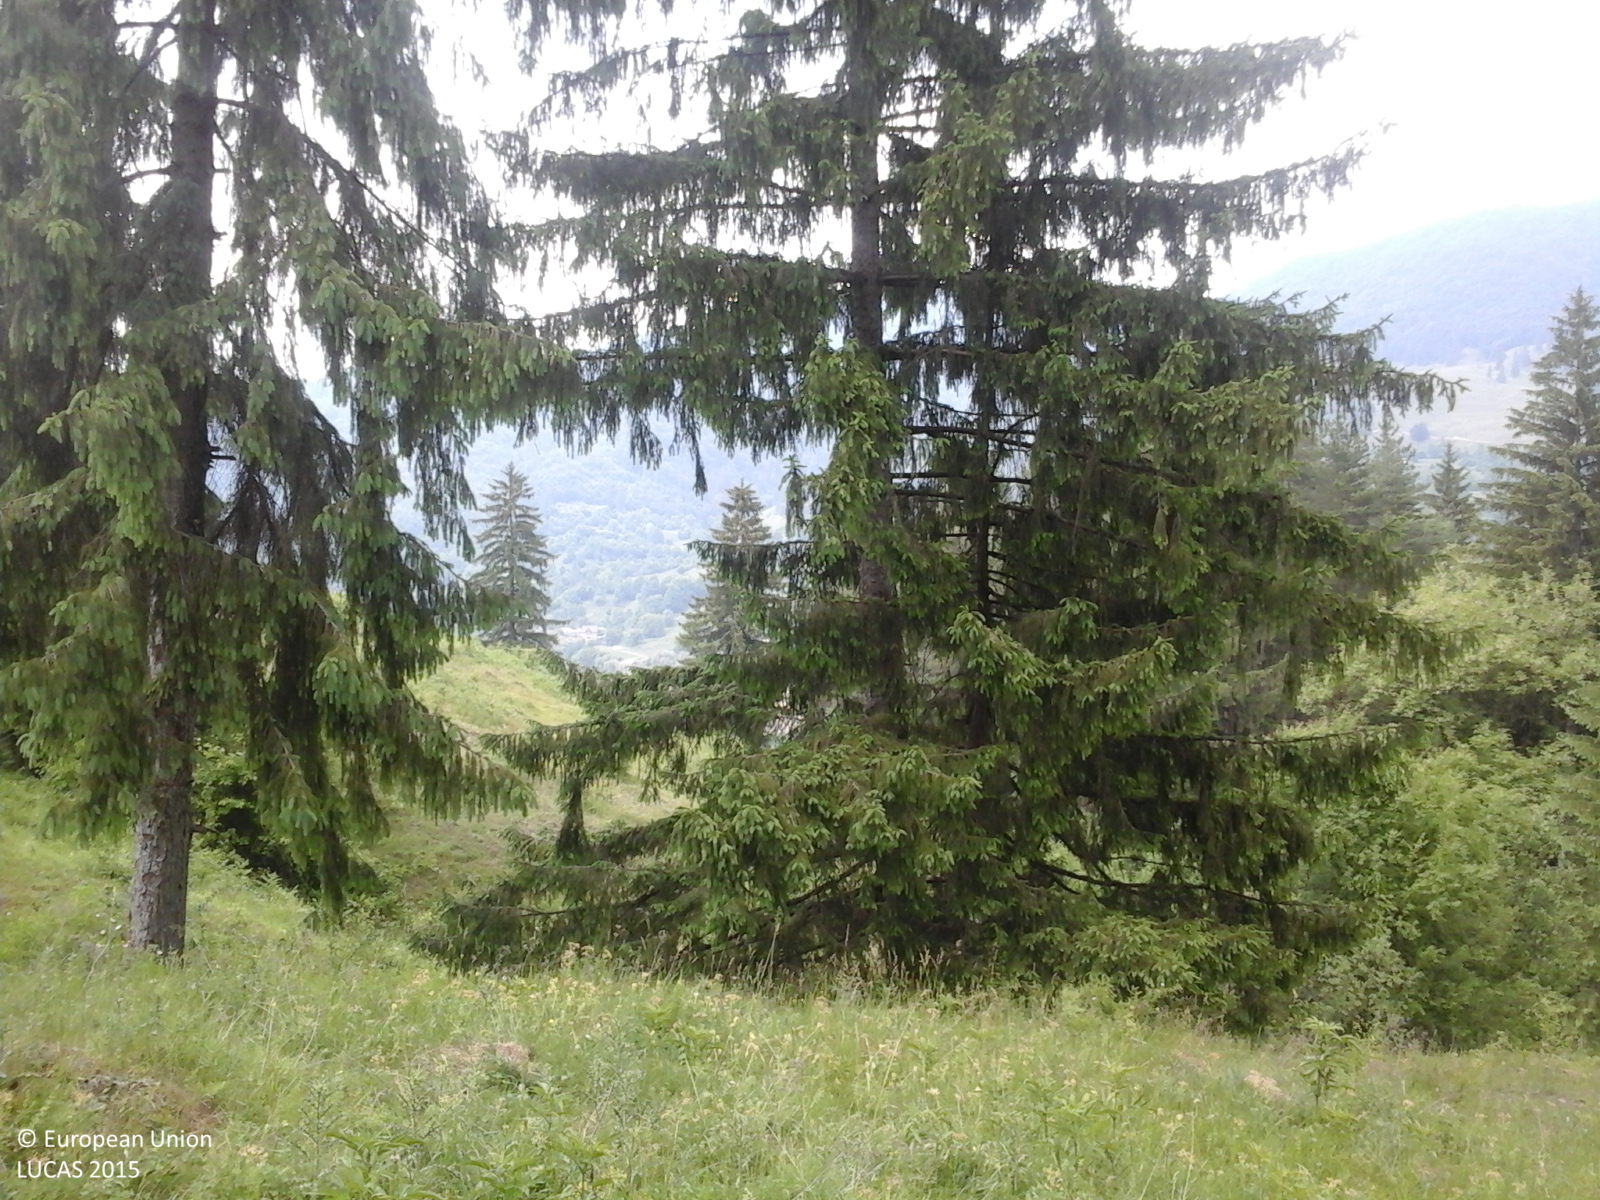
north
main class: Grassland
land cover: Grassland with sparse tree/shrub cover
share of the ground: > 75 %
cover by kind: herbaceous plants 85 %, shrubs 10 %, broadleaved forest trees 5 %
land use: Agriculture (excluding fallow land and kitchen gardens)
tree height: > 5 m
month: June
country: RO
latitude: 46.9010
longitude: 26.1023
